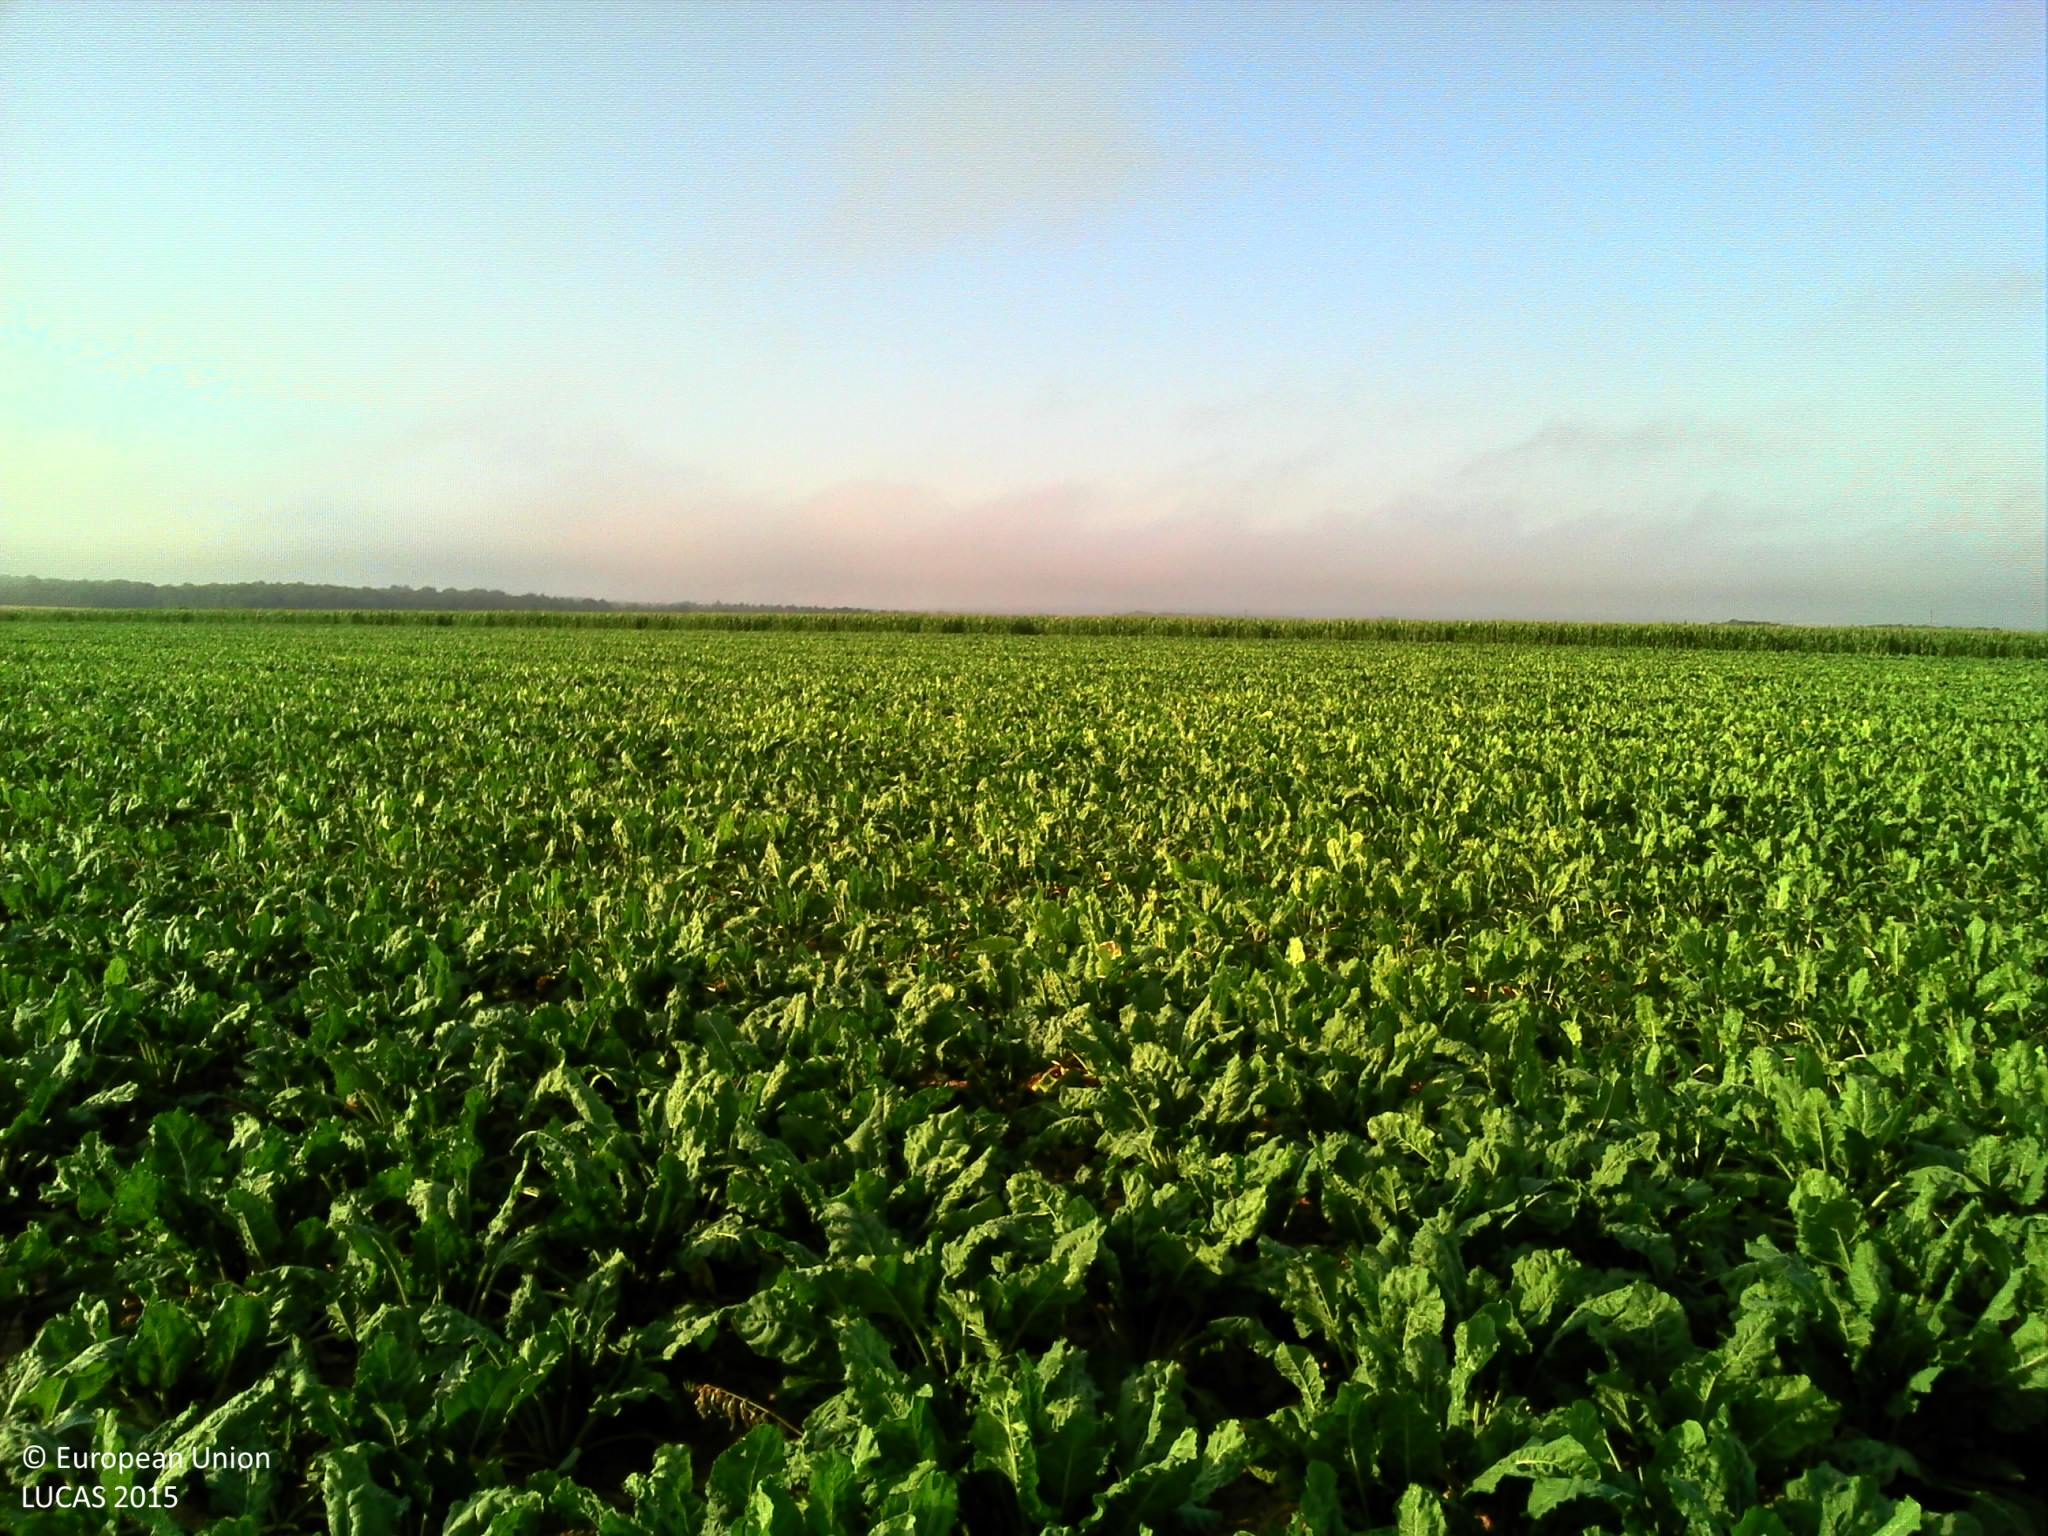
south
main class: Cropland
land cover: Sugar beet
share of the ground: > 75 %
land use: Agriculture (excluding fallow land and kitchen gardens)
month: July
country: FR
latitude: 49.3488
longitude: 2.3474
